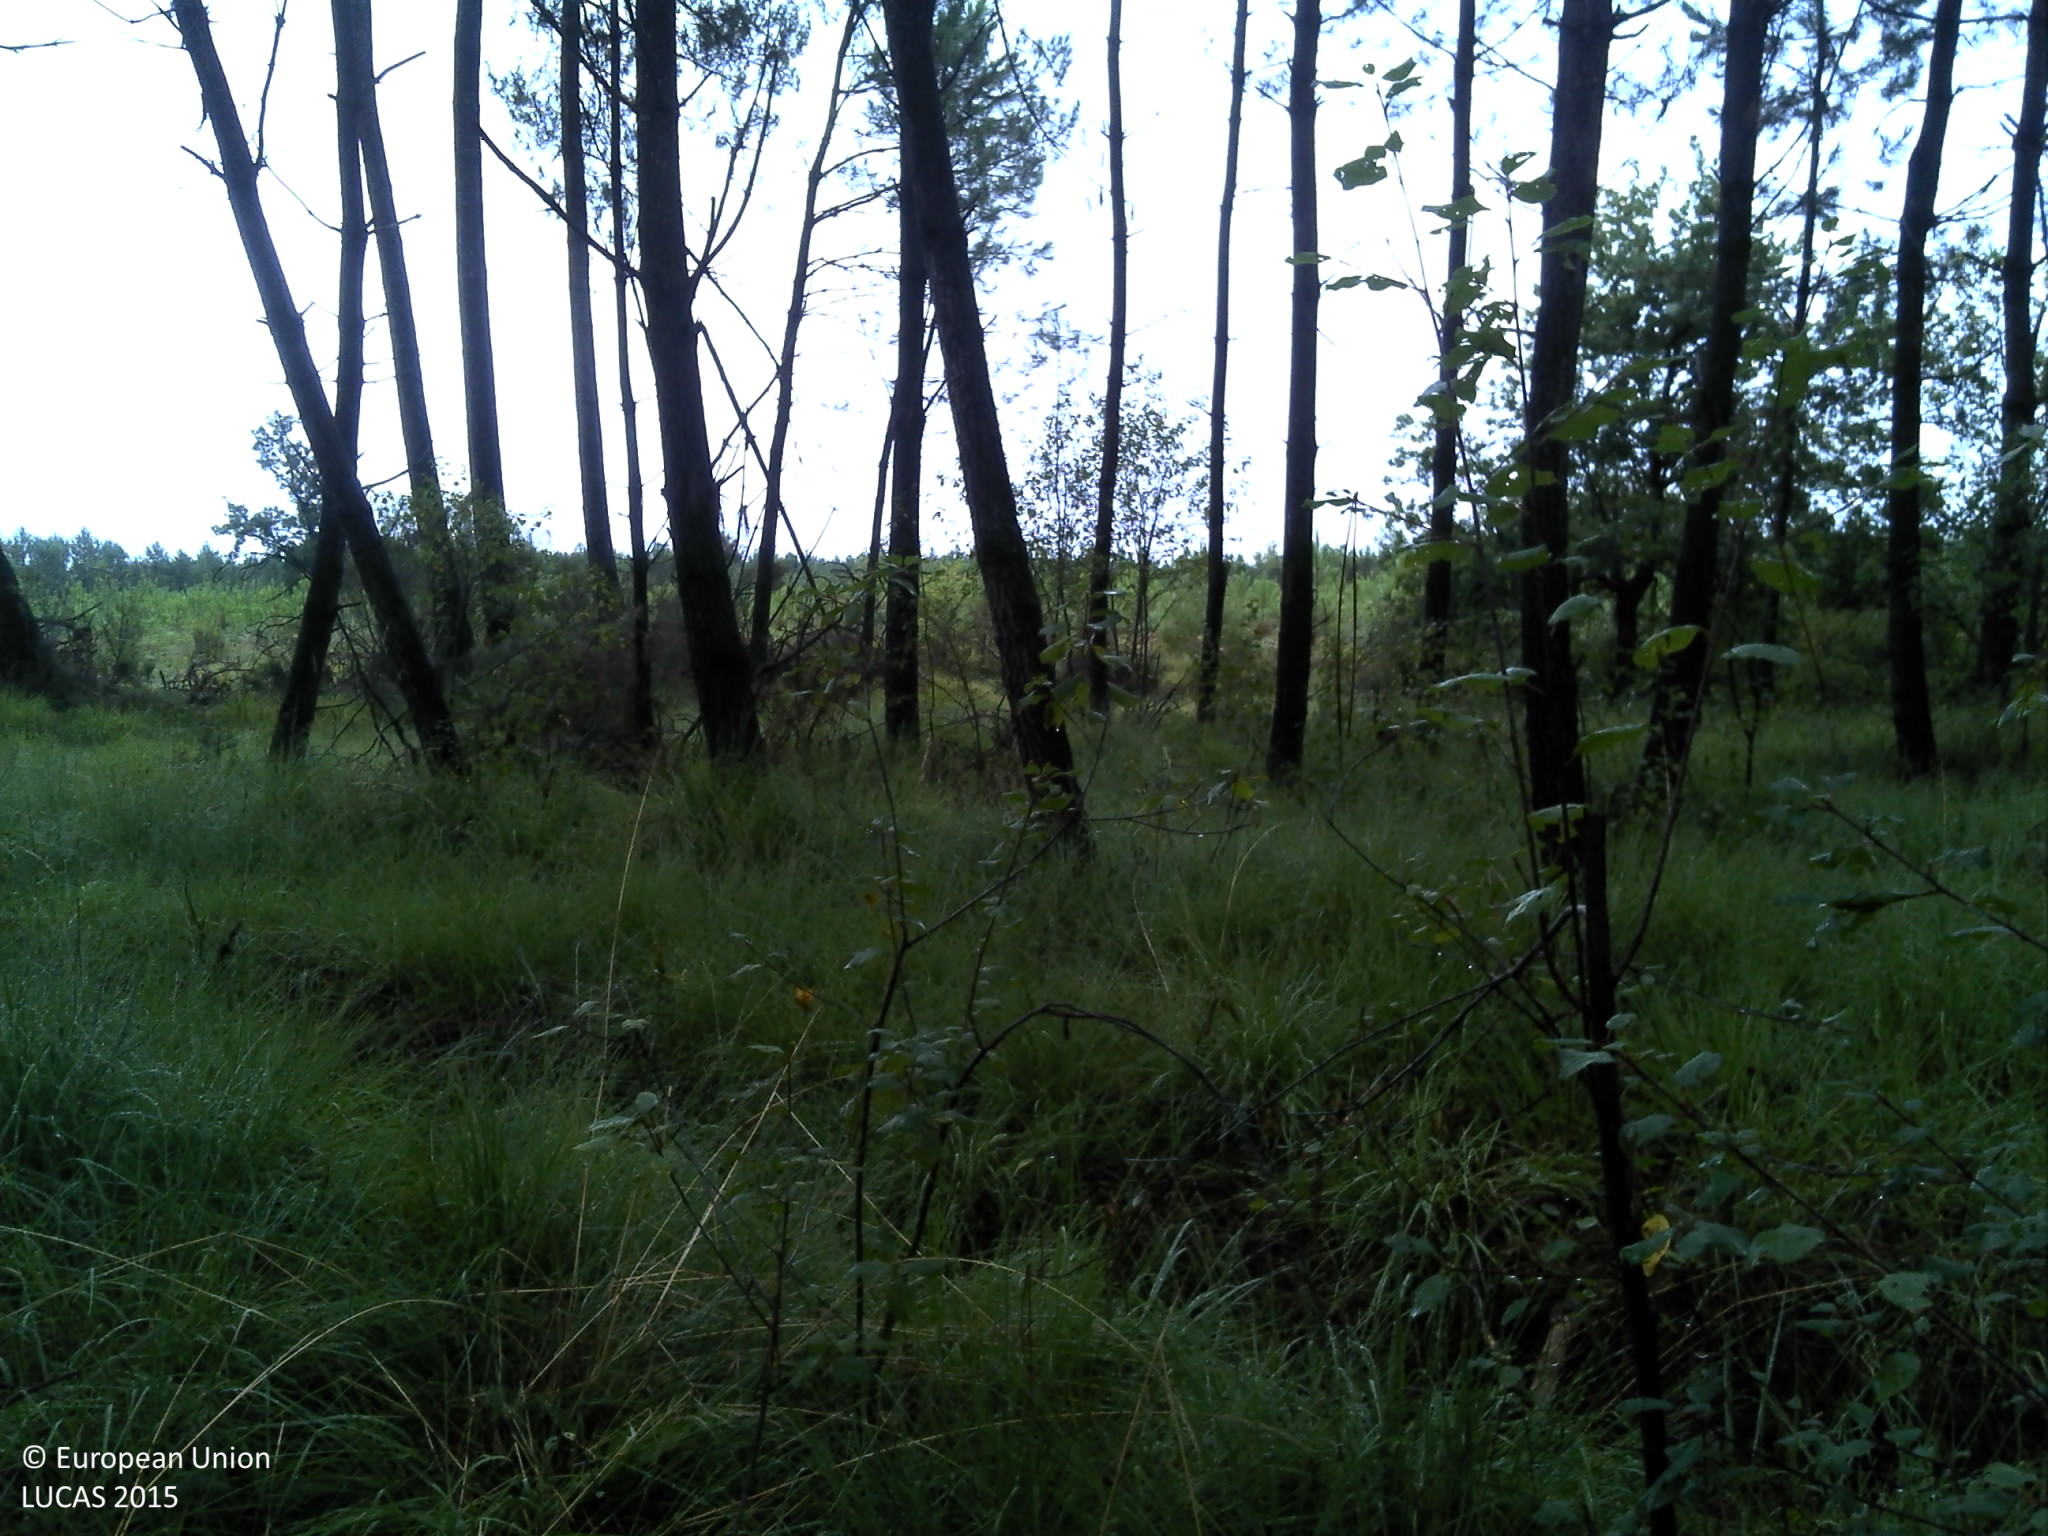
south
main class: Woodland
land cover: Pine dominated coniferous woodland
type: coniferous forest of the mediterranean region
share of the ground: > 75 %
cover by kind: coniferous forest trees 60 %, shrubs 30 %, herbaceous plants 5 %, lichens and mosses 5 %
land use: Forestry
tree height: > 5 m
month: August
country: FR
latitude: 44.6478
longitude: -0.5455
